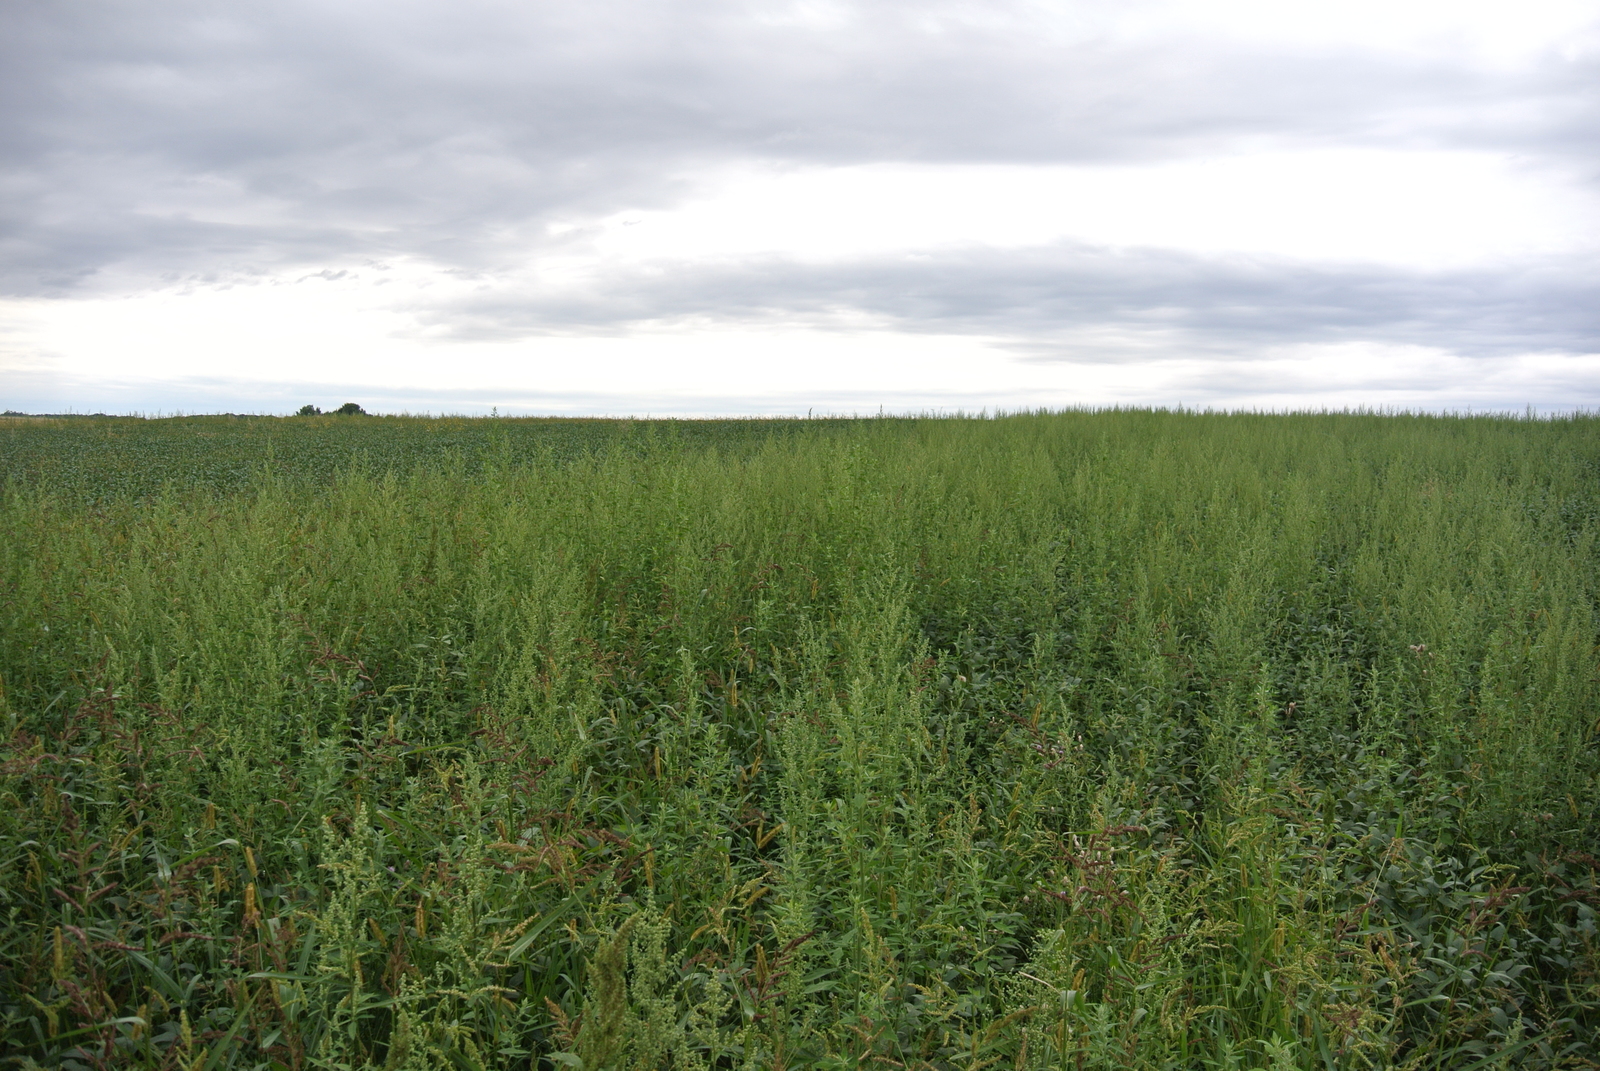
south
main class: Grassland
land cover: Spontaneously vegetated surfaces
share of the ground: > 75 %
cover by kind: herbaceous plants 100 %
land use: Agriculture (excluding fallow land and kitchen gardens)
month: July
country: AT
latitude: 47.5378
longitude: 16.6068
